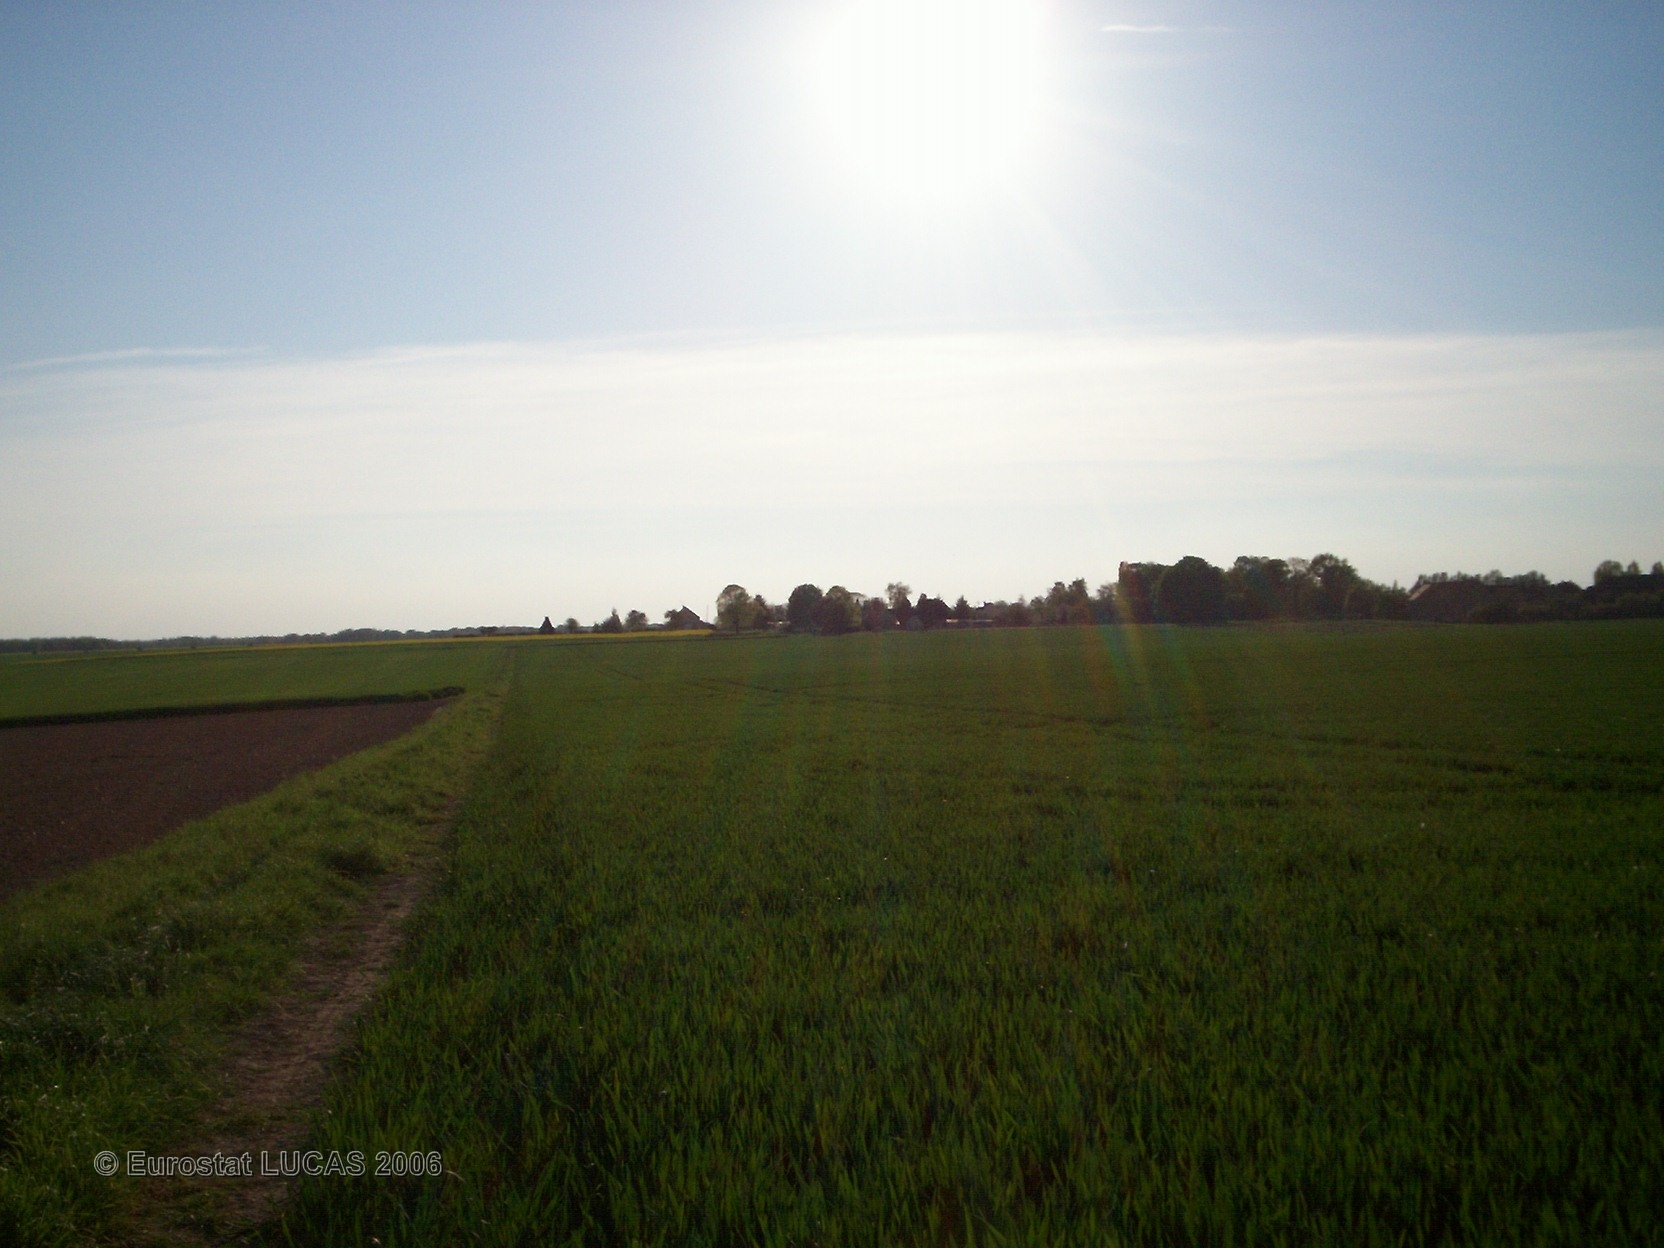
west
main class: Cropland
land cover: Common wheat
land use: Agriculture (excluding fallow land and kitchen gardens)
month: May
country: FR
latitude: 48.1968
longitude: 2.9560
